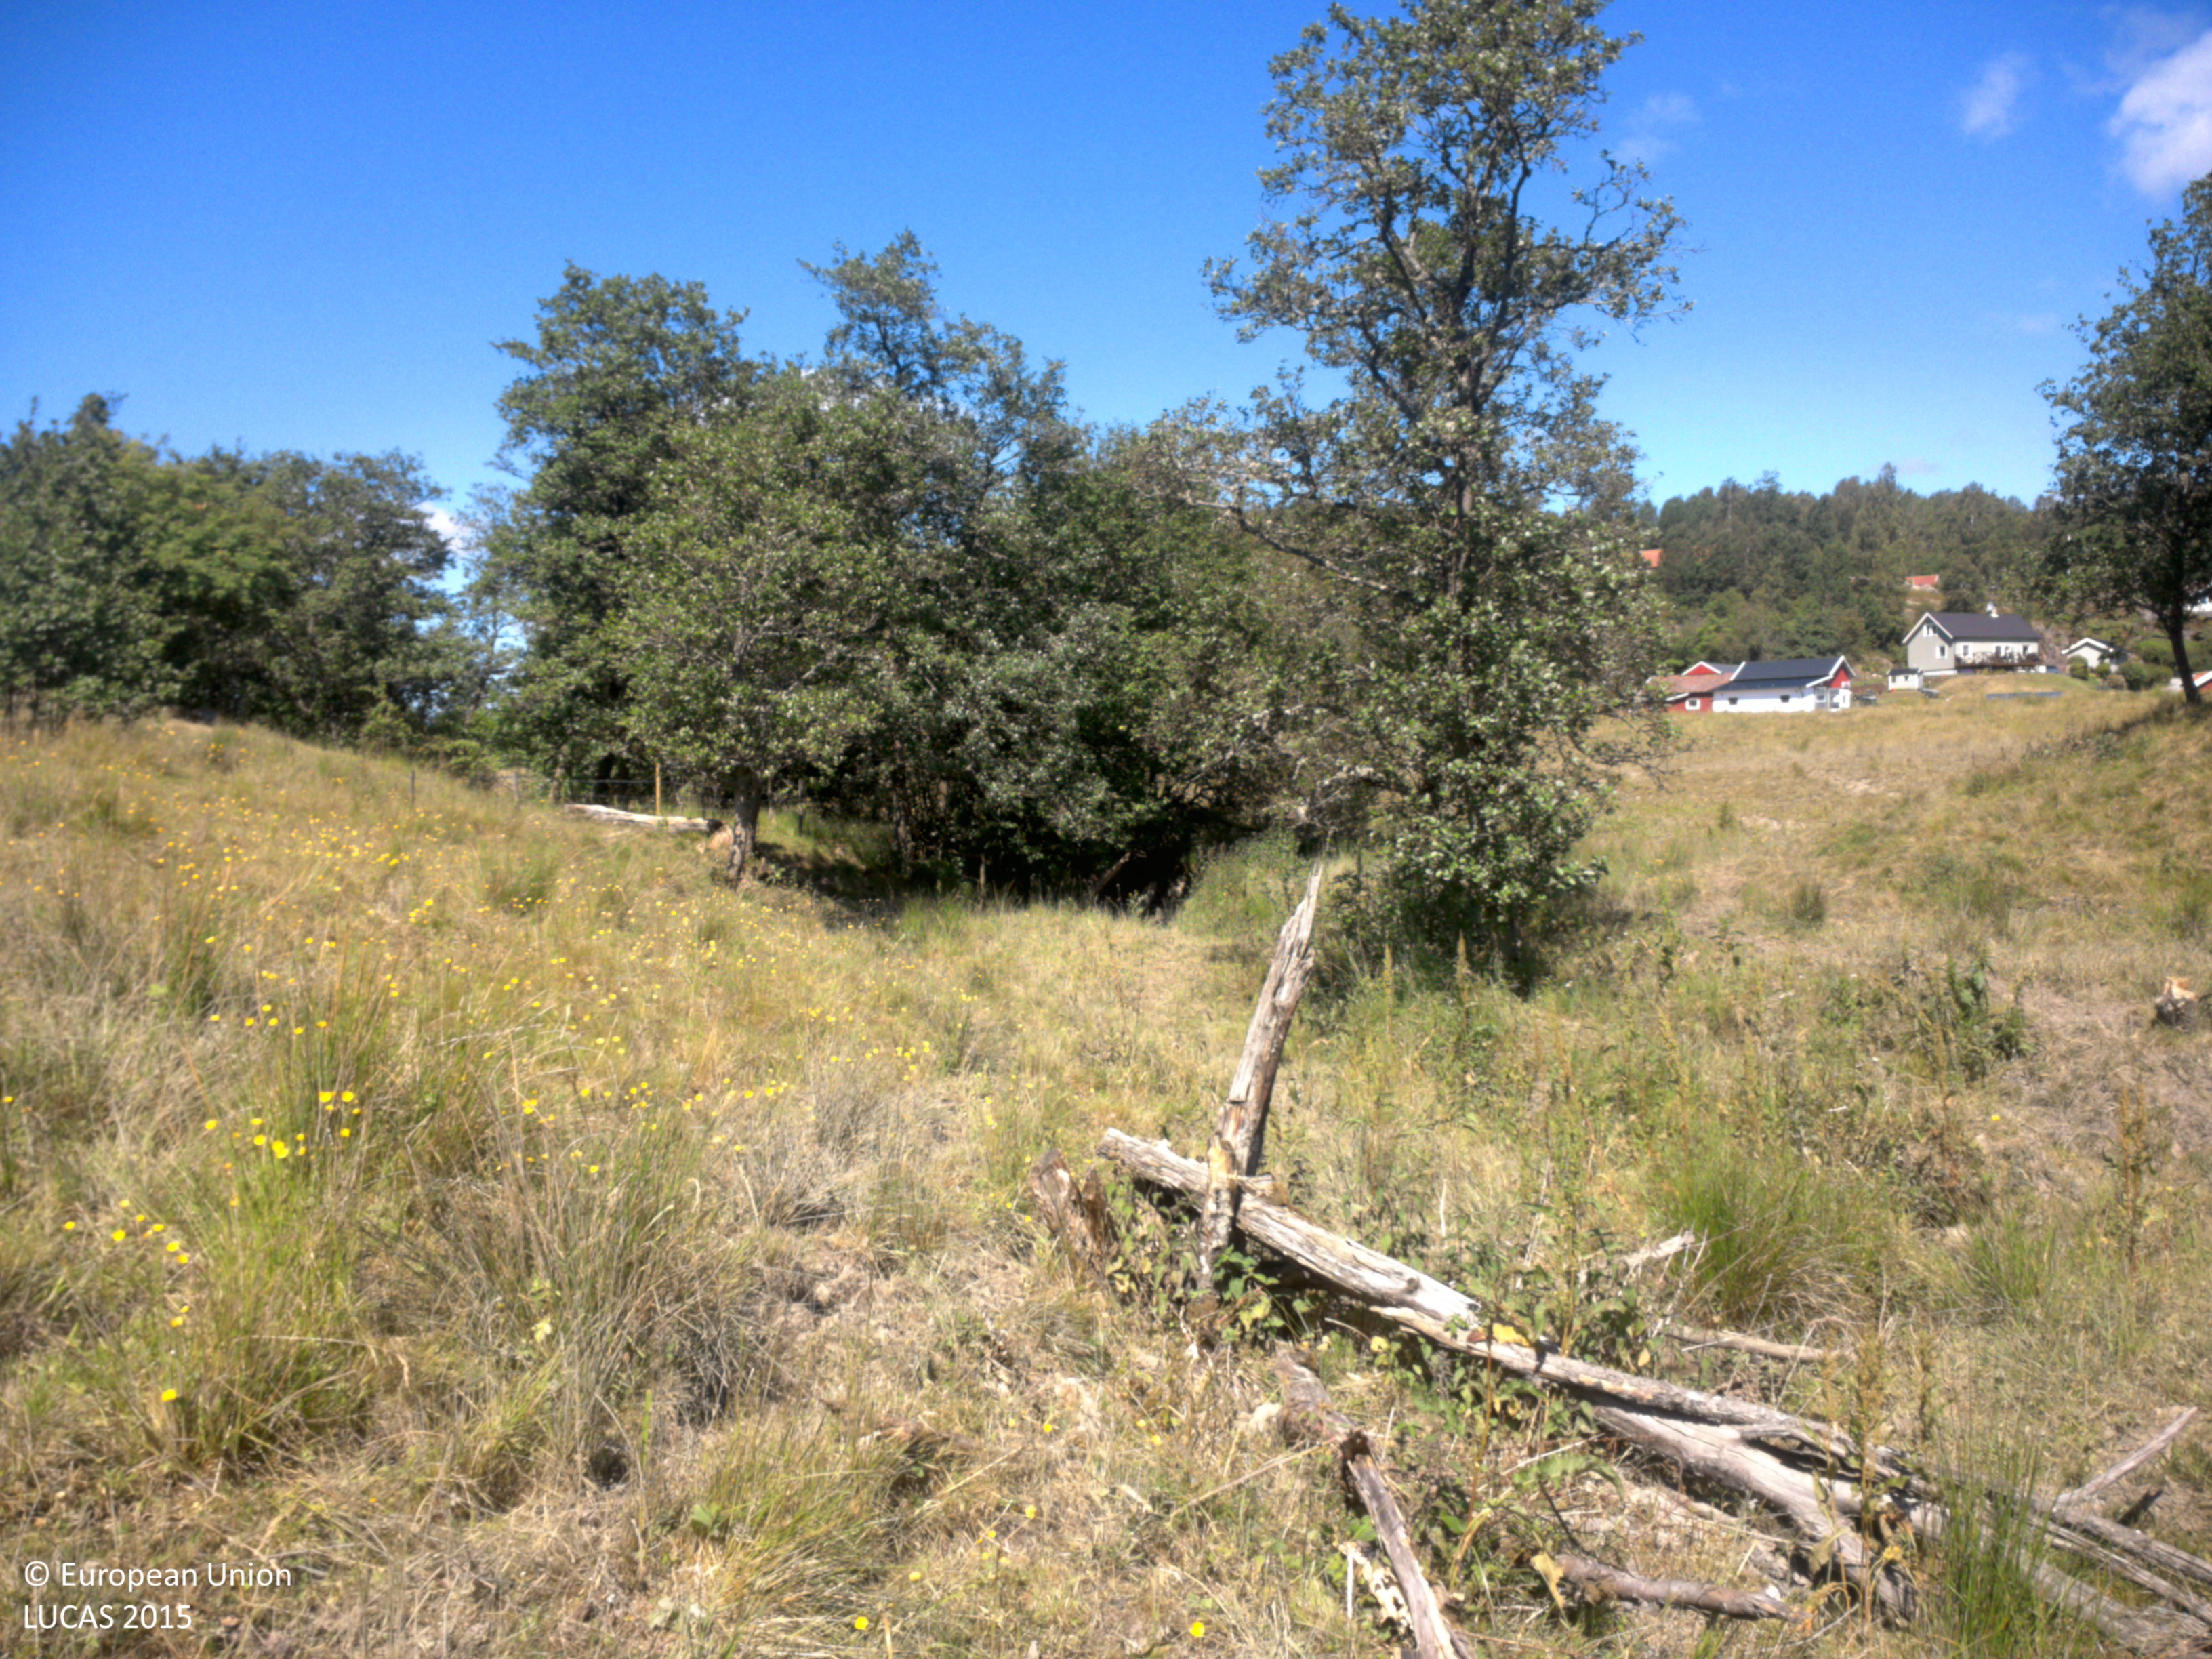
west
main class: Grassland
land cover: Grassland with sparse tree/shrub cover
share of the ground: > 75 %
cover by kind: herbaceous plants 95 %, broadleaved forest trees 5 %
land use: Agriculture (excluding fallow land and kitchen gardens)
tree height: > 5 m
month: June
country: SE
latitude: 58.4979
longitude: 11.5923
